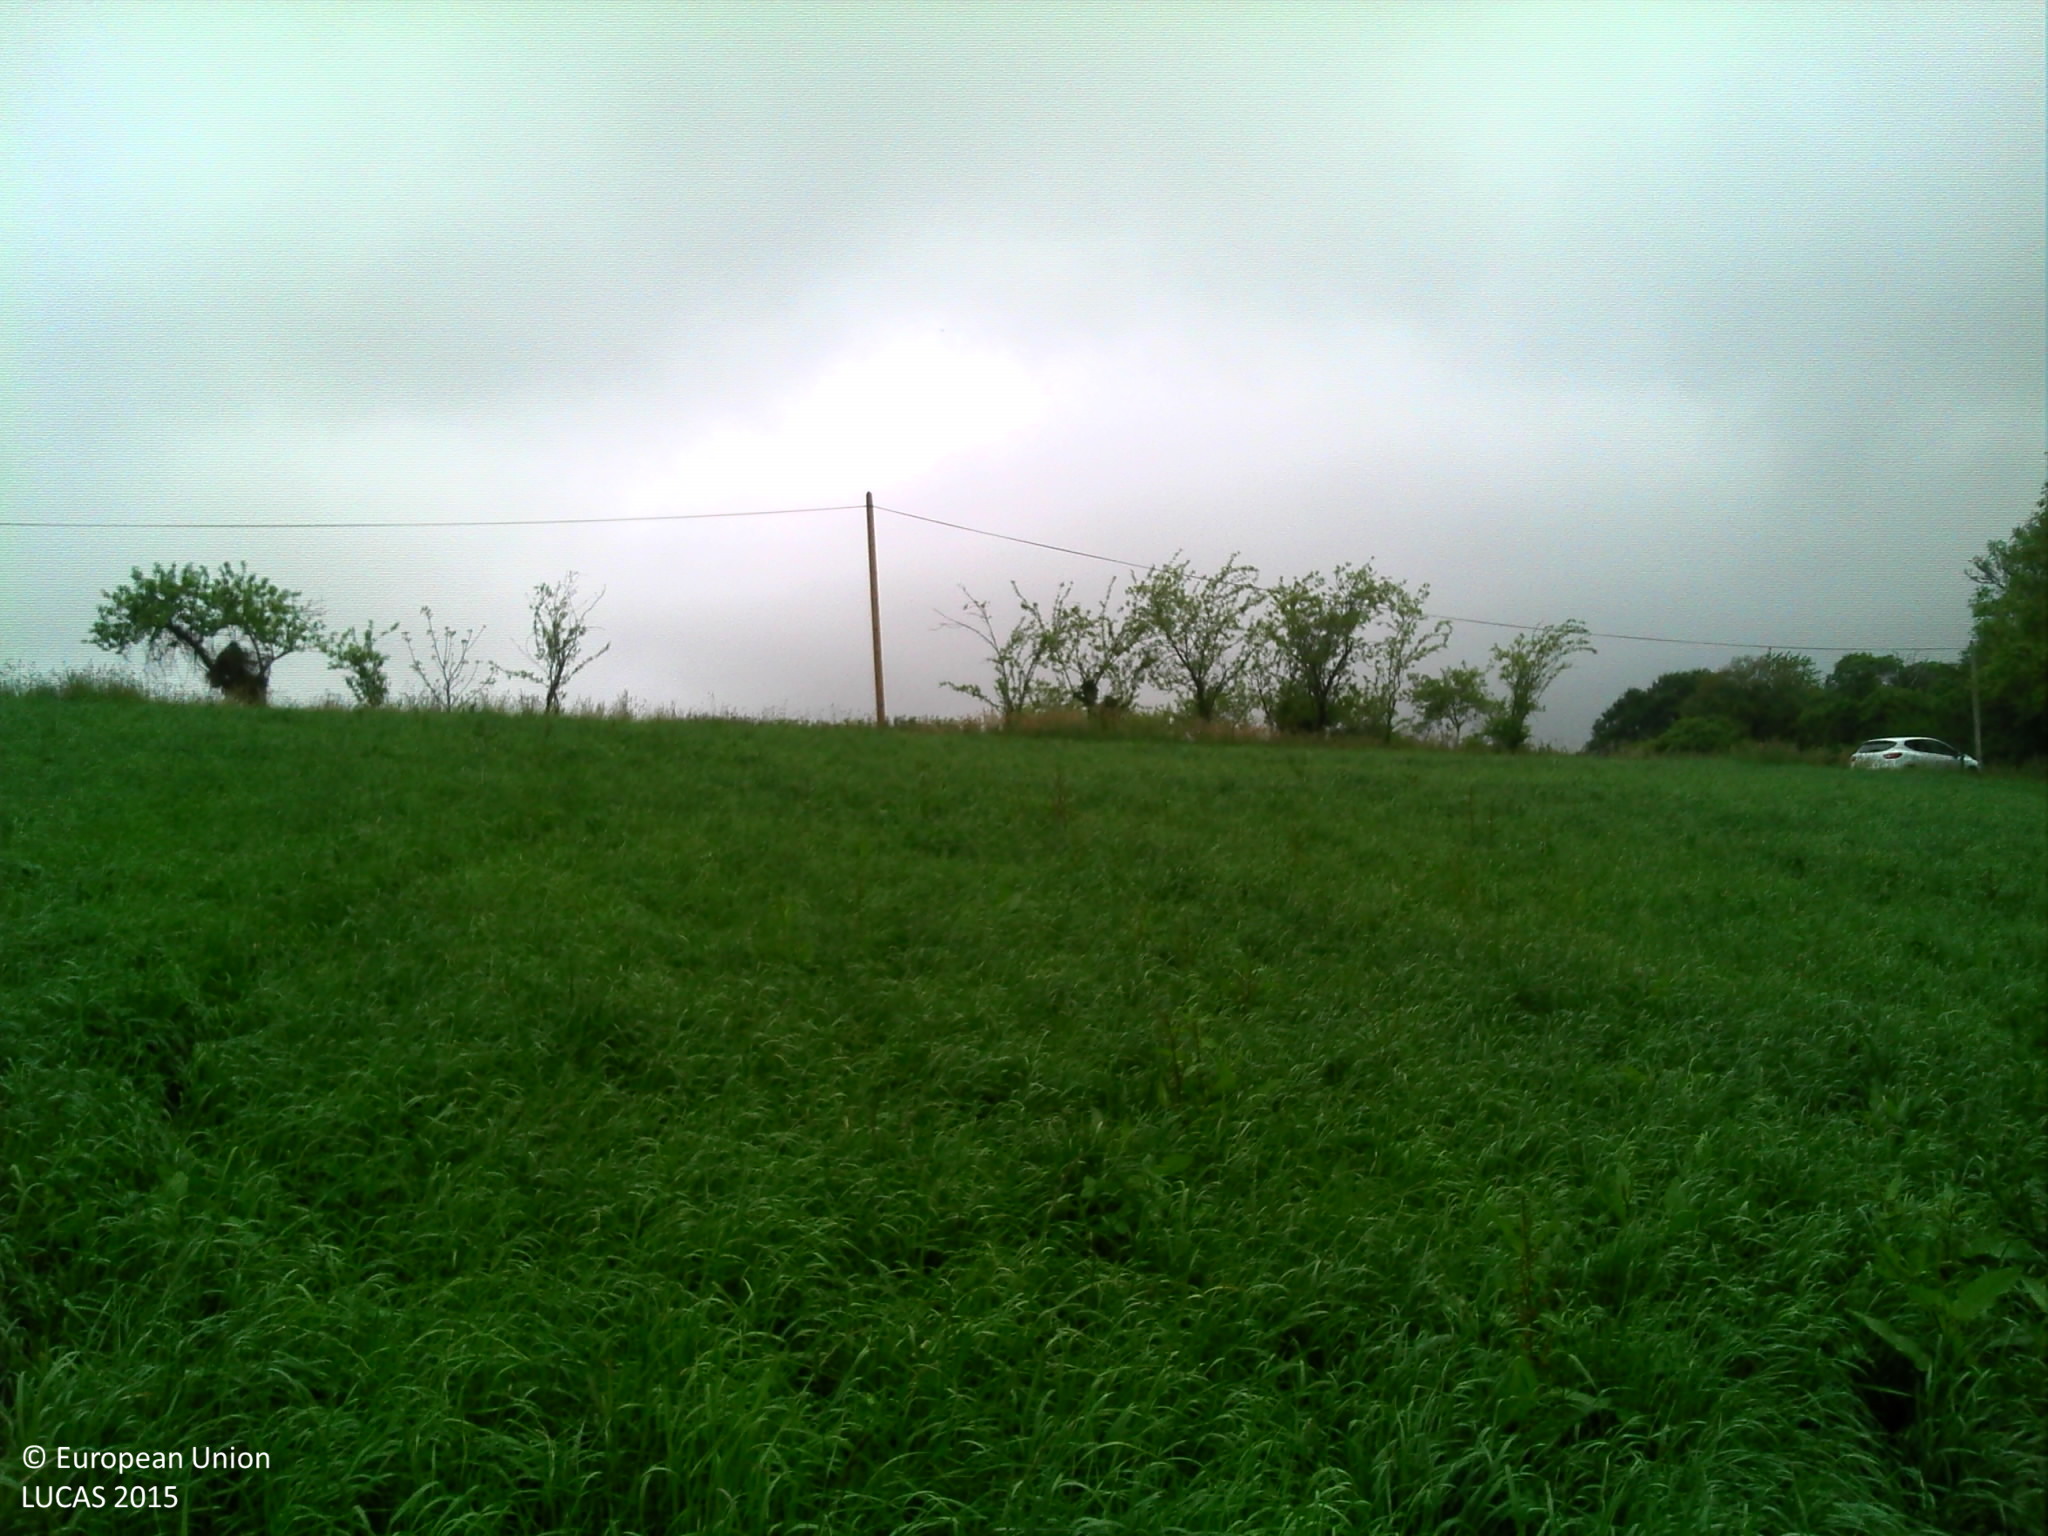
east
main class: Cropland
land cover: Temporary grasslands
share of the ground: > 75 %
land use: Agriculture (excluding fallow land and kitchen gardens)
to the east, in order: Temporary grasslands; Grass margins; Paved roads, cycling and walking lanes; Grass margins; Electric lines; Abandoned hedges; Grassland without tree/shrub cover; Abandoned hedges; Maize; Tracks; Broadleaved woodland
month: June
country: FR
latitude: 44.7283
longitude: 1.9817
